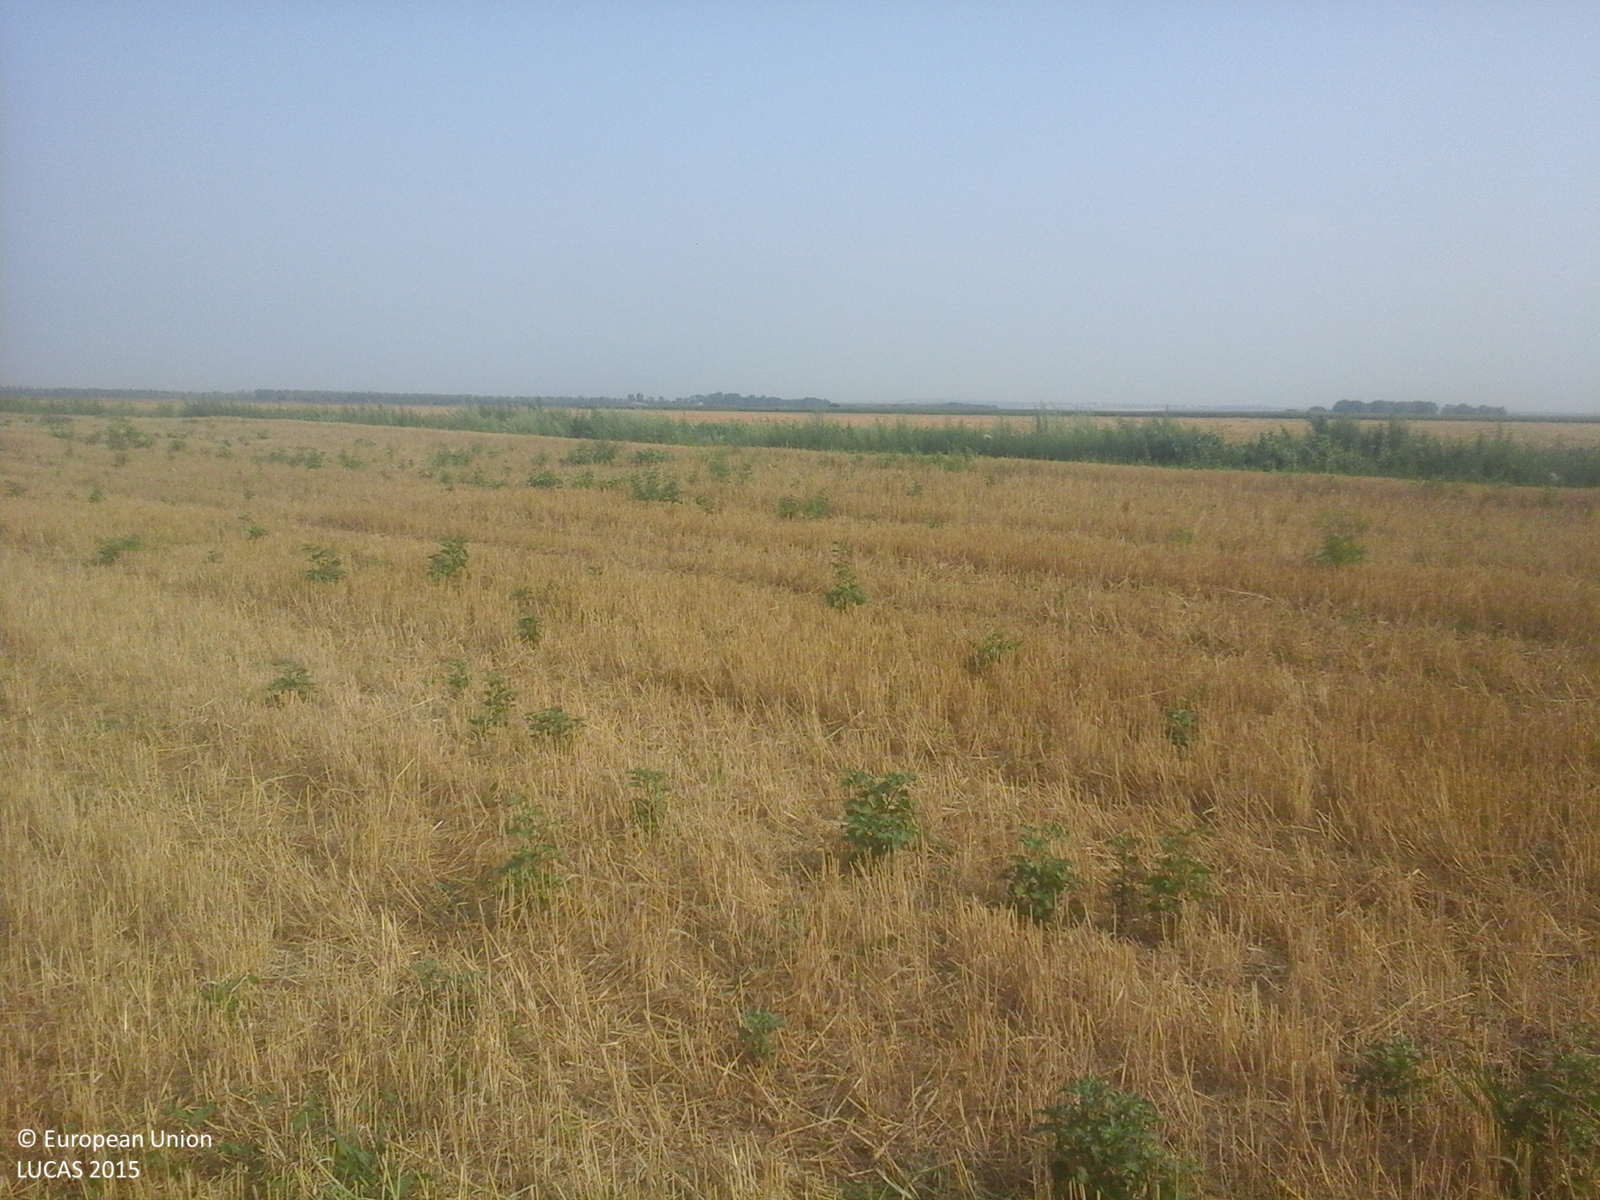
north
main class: Cropland
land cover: Durum wheat
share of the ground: > 75 %
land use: Agriculture (excluding fallow land and kitchen gardens)
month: July
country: RO
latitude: 45.3911
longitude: 28.2496
